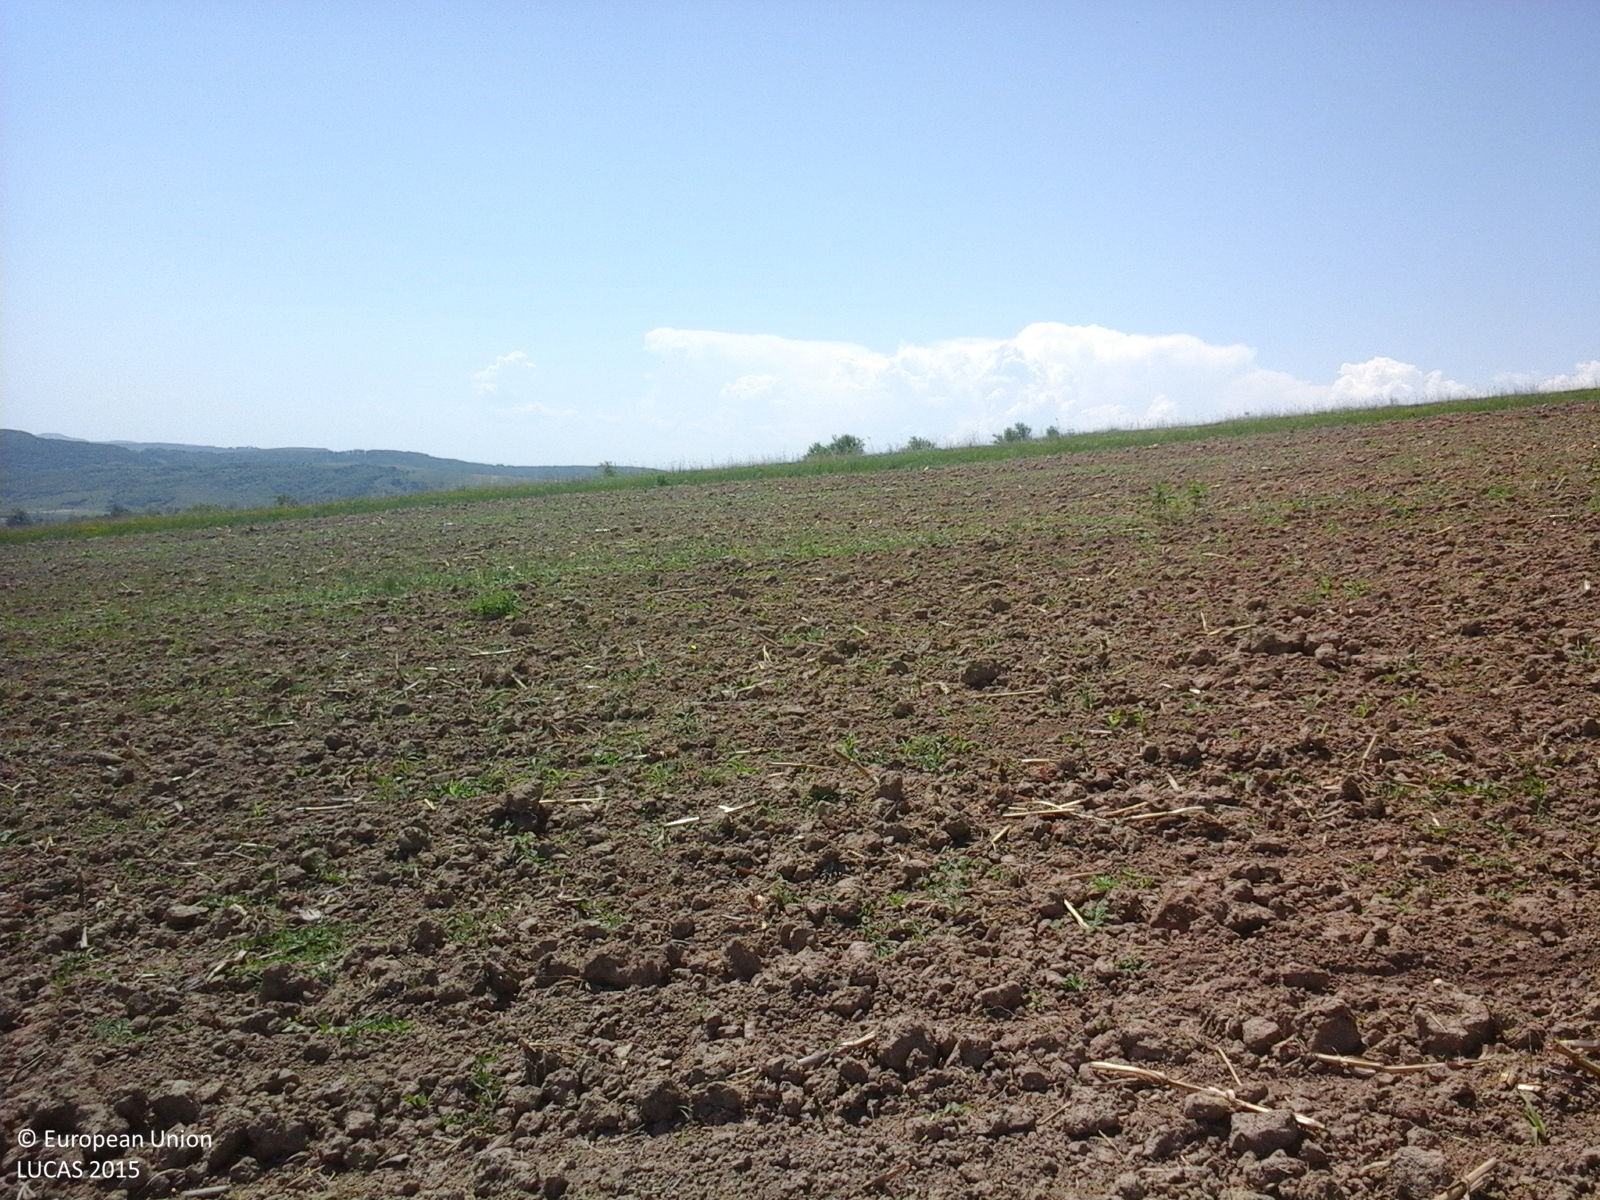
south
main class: Cropland
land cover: Maize
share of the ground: < 10 %
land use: Agriculture (excluding fallow land and kitchen gardens)
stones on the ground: < 10 %
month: June
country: RO
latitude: 46.5476
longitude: 26.6091
